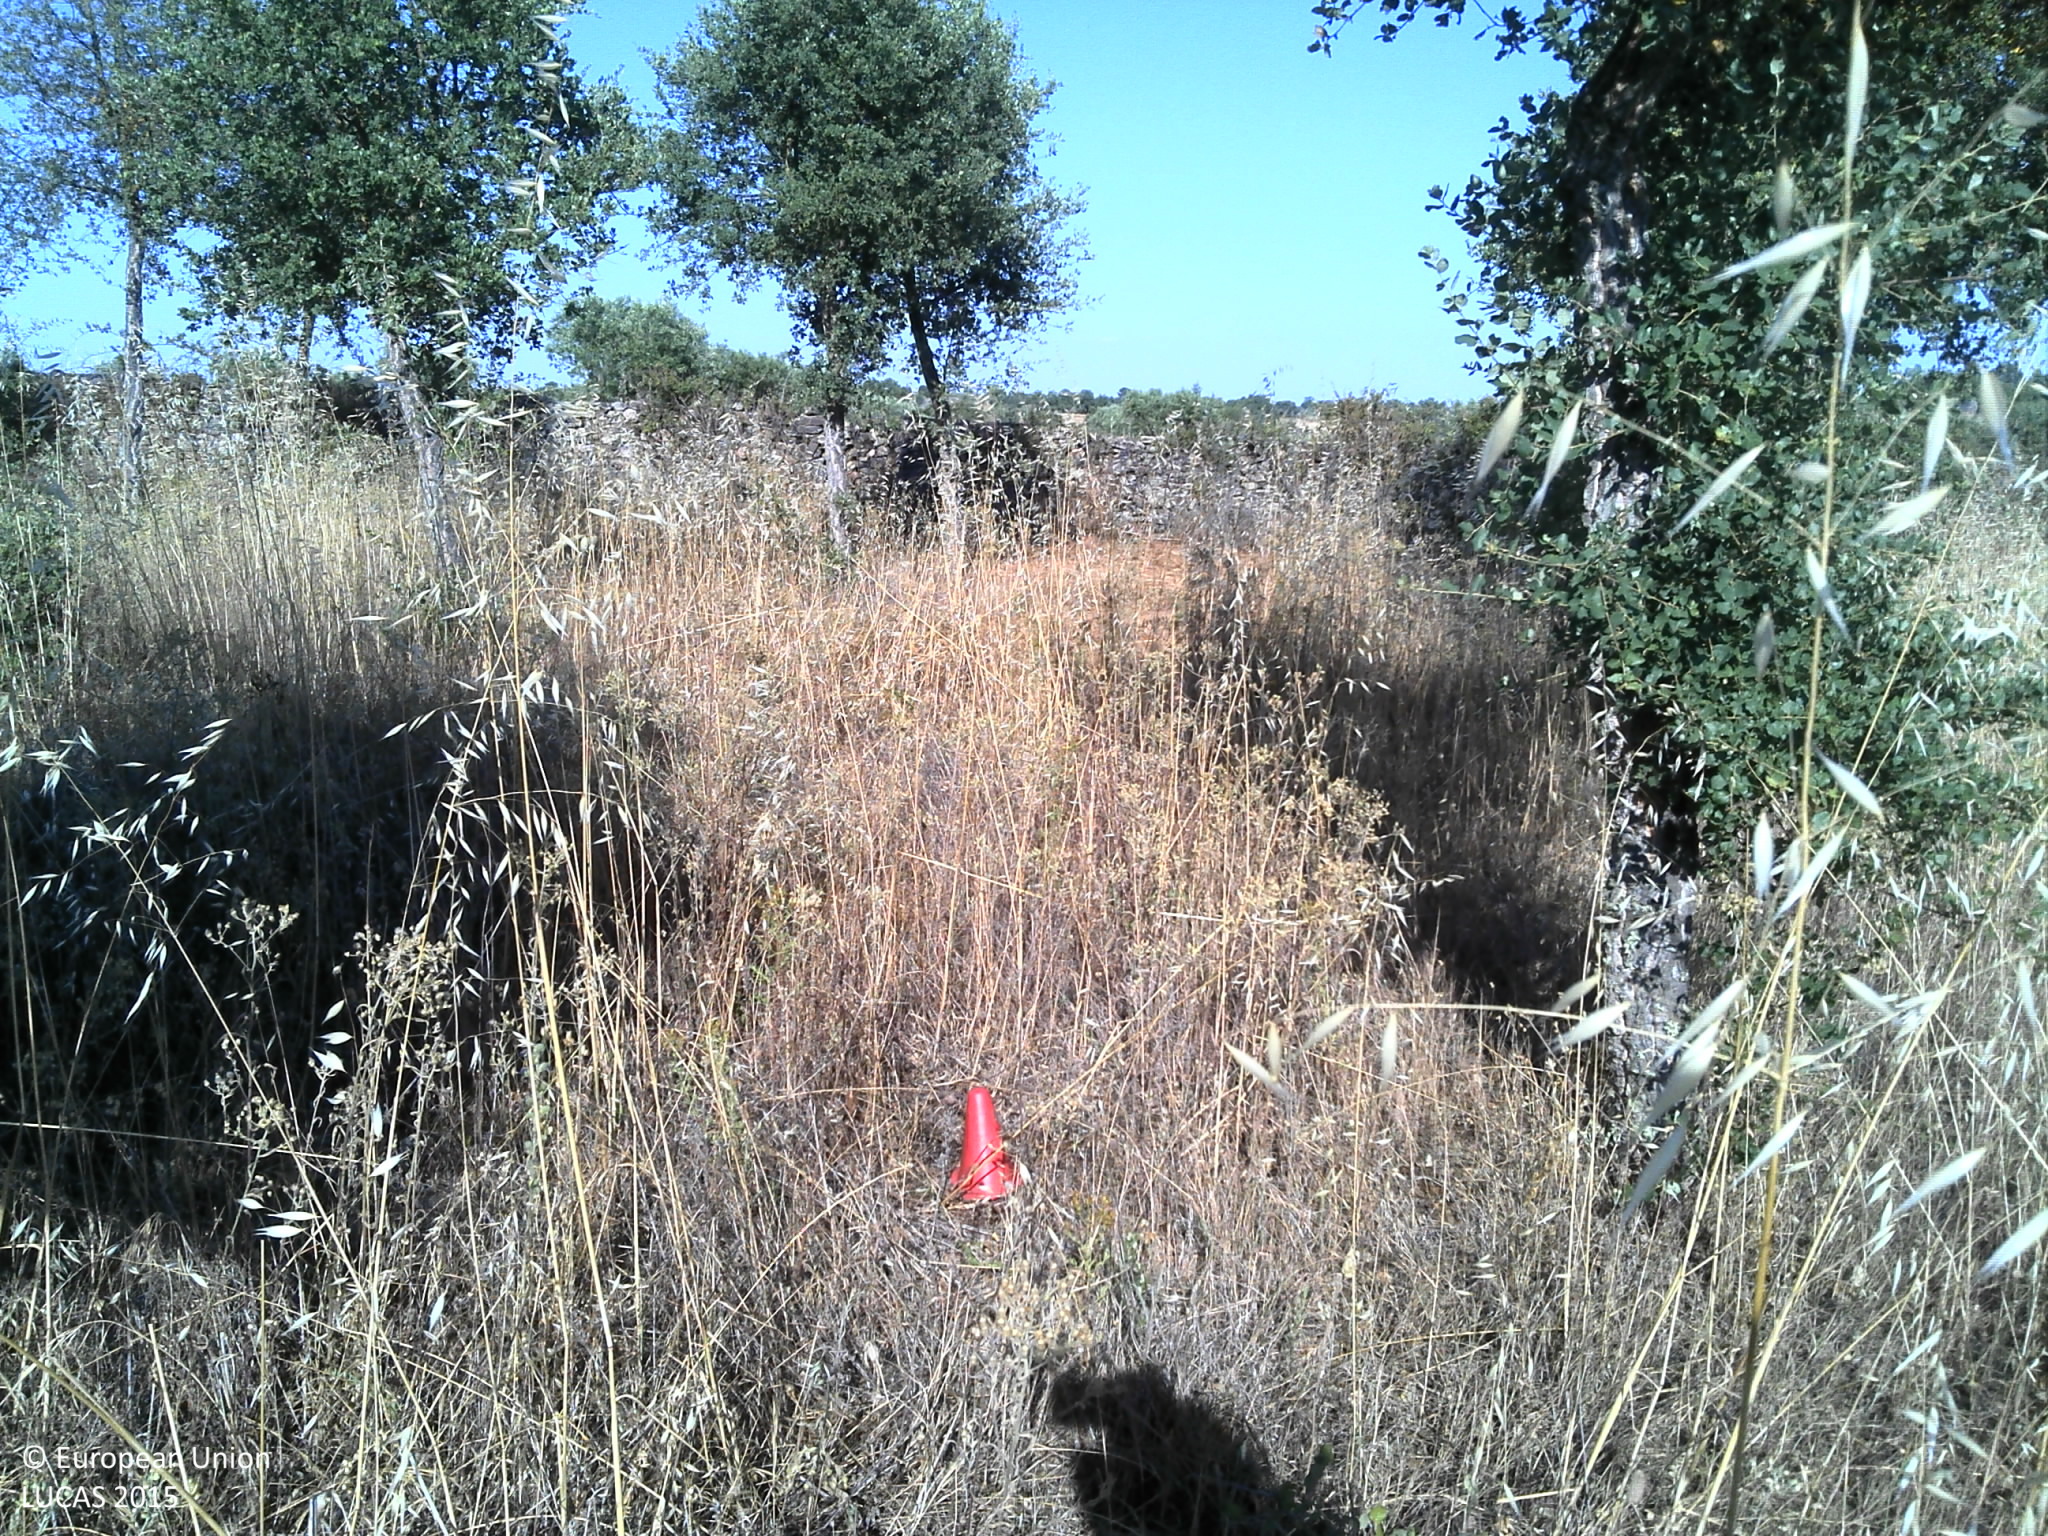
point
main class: Woodland
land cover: Broadleaved woodland
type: broadleaved evergreen forest
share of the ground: < 10 %
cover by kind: herbaceous plants 90 %, broadleaved forest trees 10 %
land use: Forestry
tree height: > 5 m
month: June
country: PT
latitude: 40.8244
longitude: -6.8547
